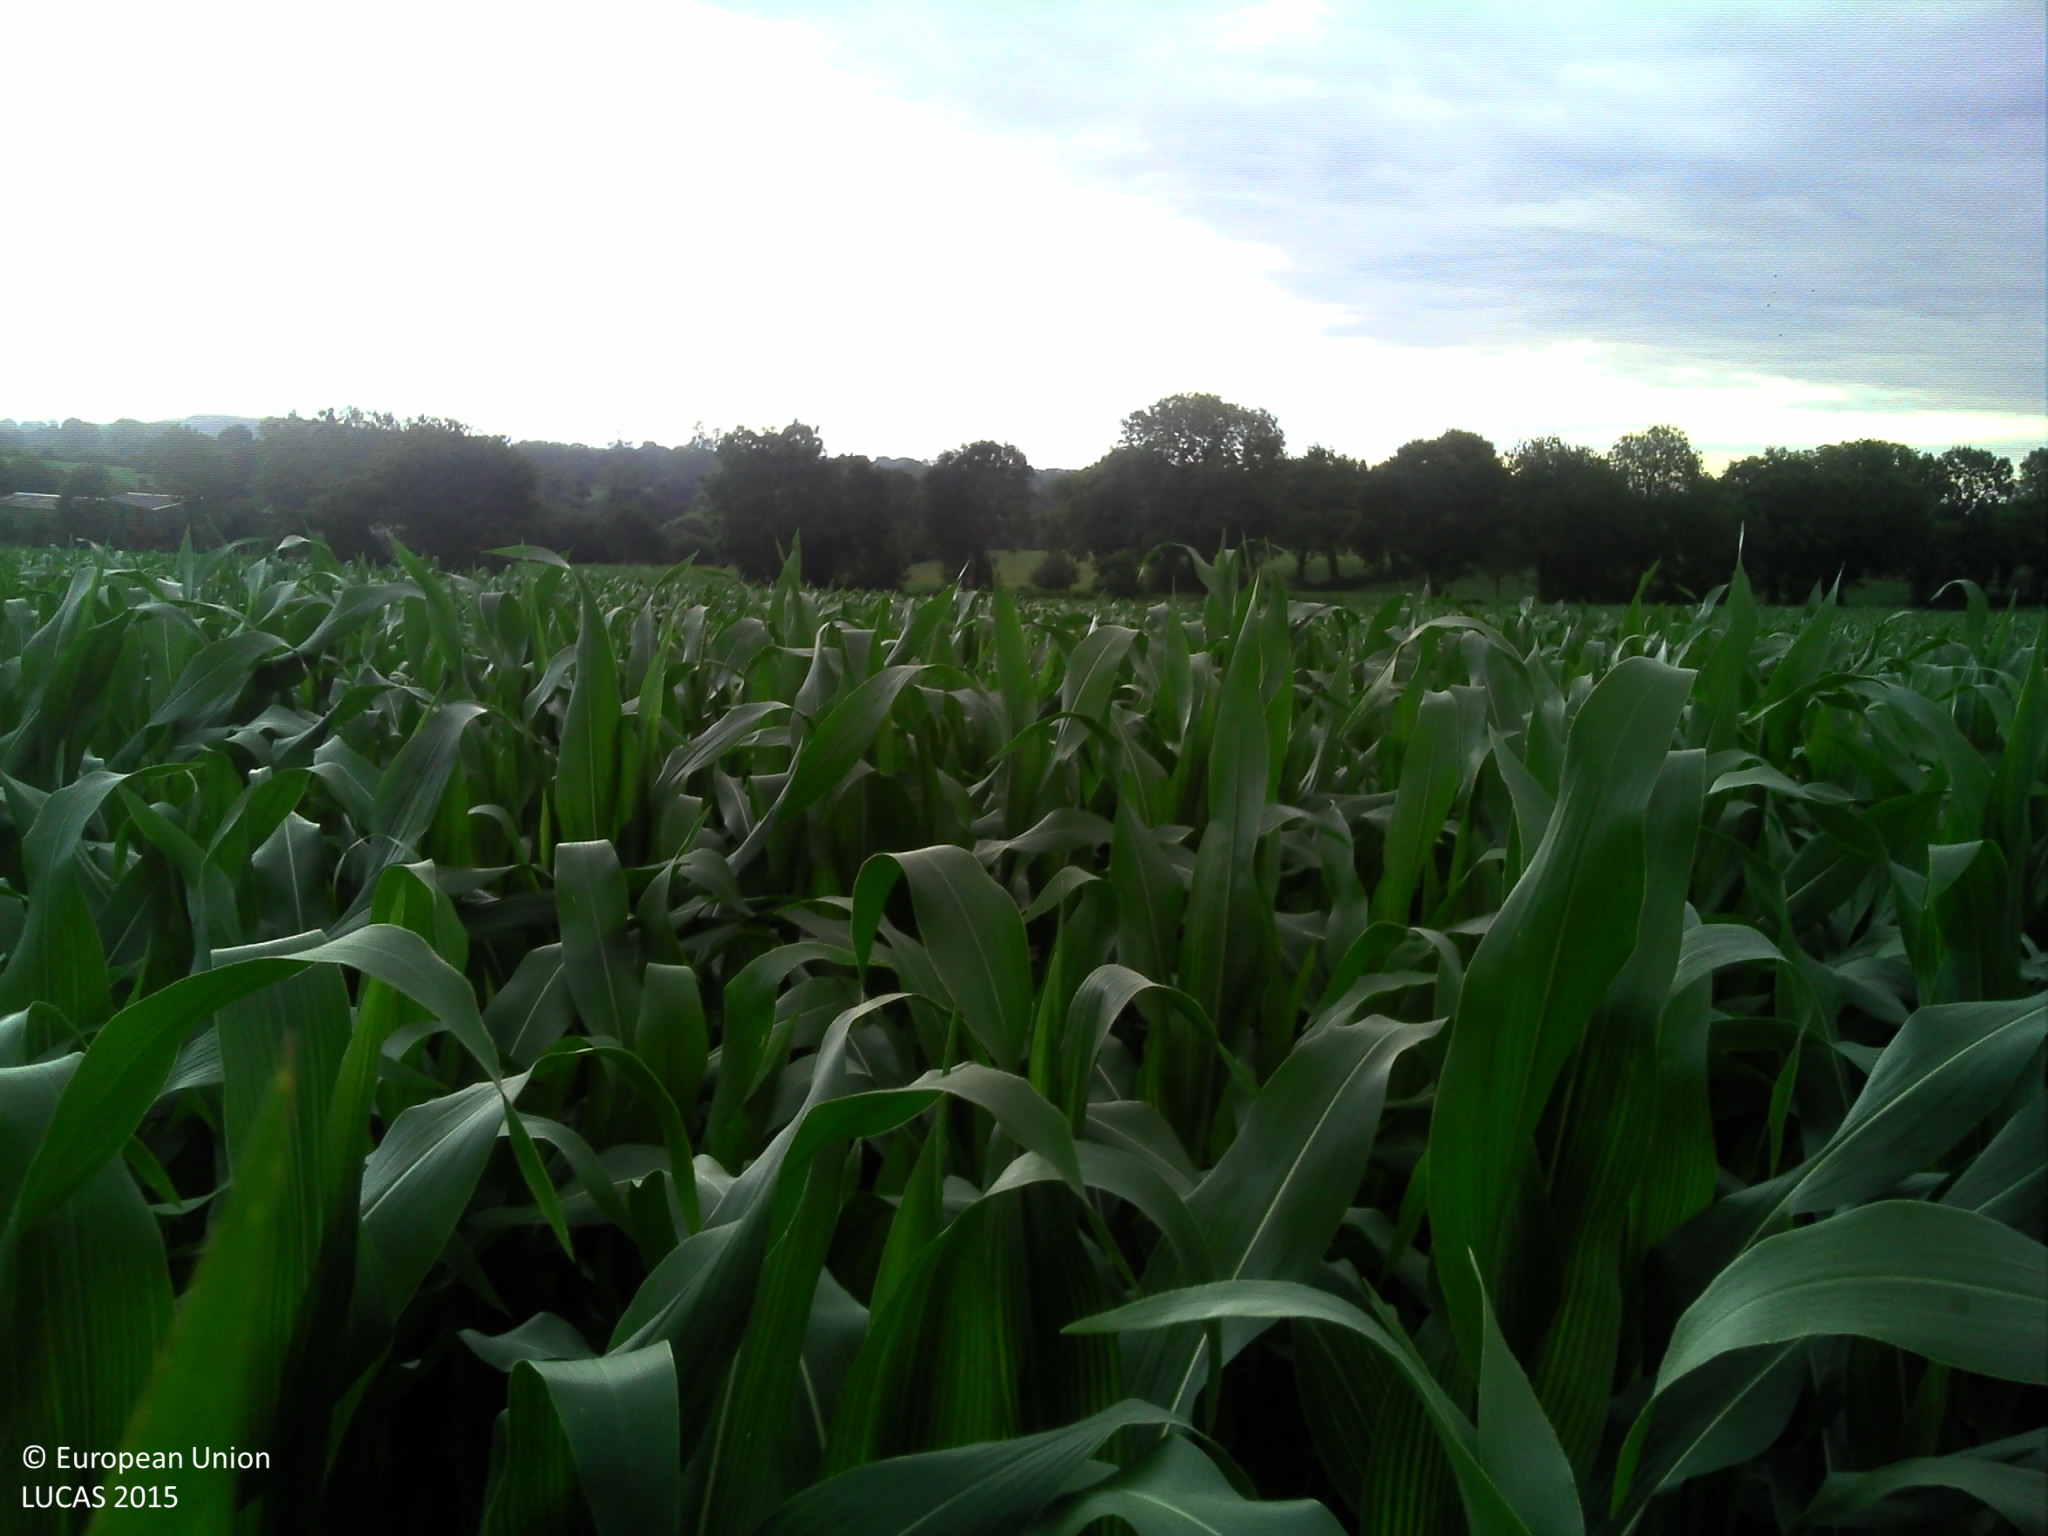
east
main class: Cropland
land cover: Maize
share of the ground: > 75 %
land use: Agriculture (excluding fallow land and kitchen gardens)
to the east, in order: Maize; Electric lines; Maize; Abandoned hedges; Maize; Grass margins; Maize
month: July
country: FR
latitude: 48.7726
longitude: -1.2429
